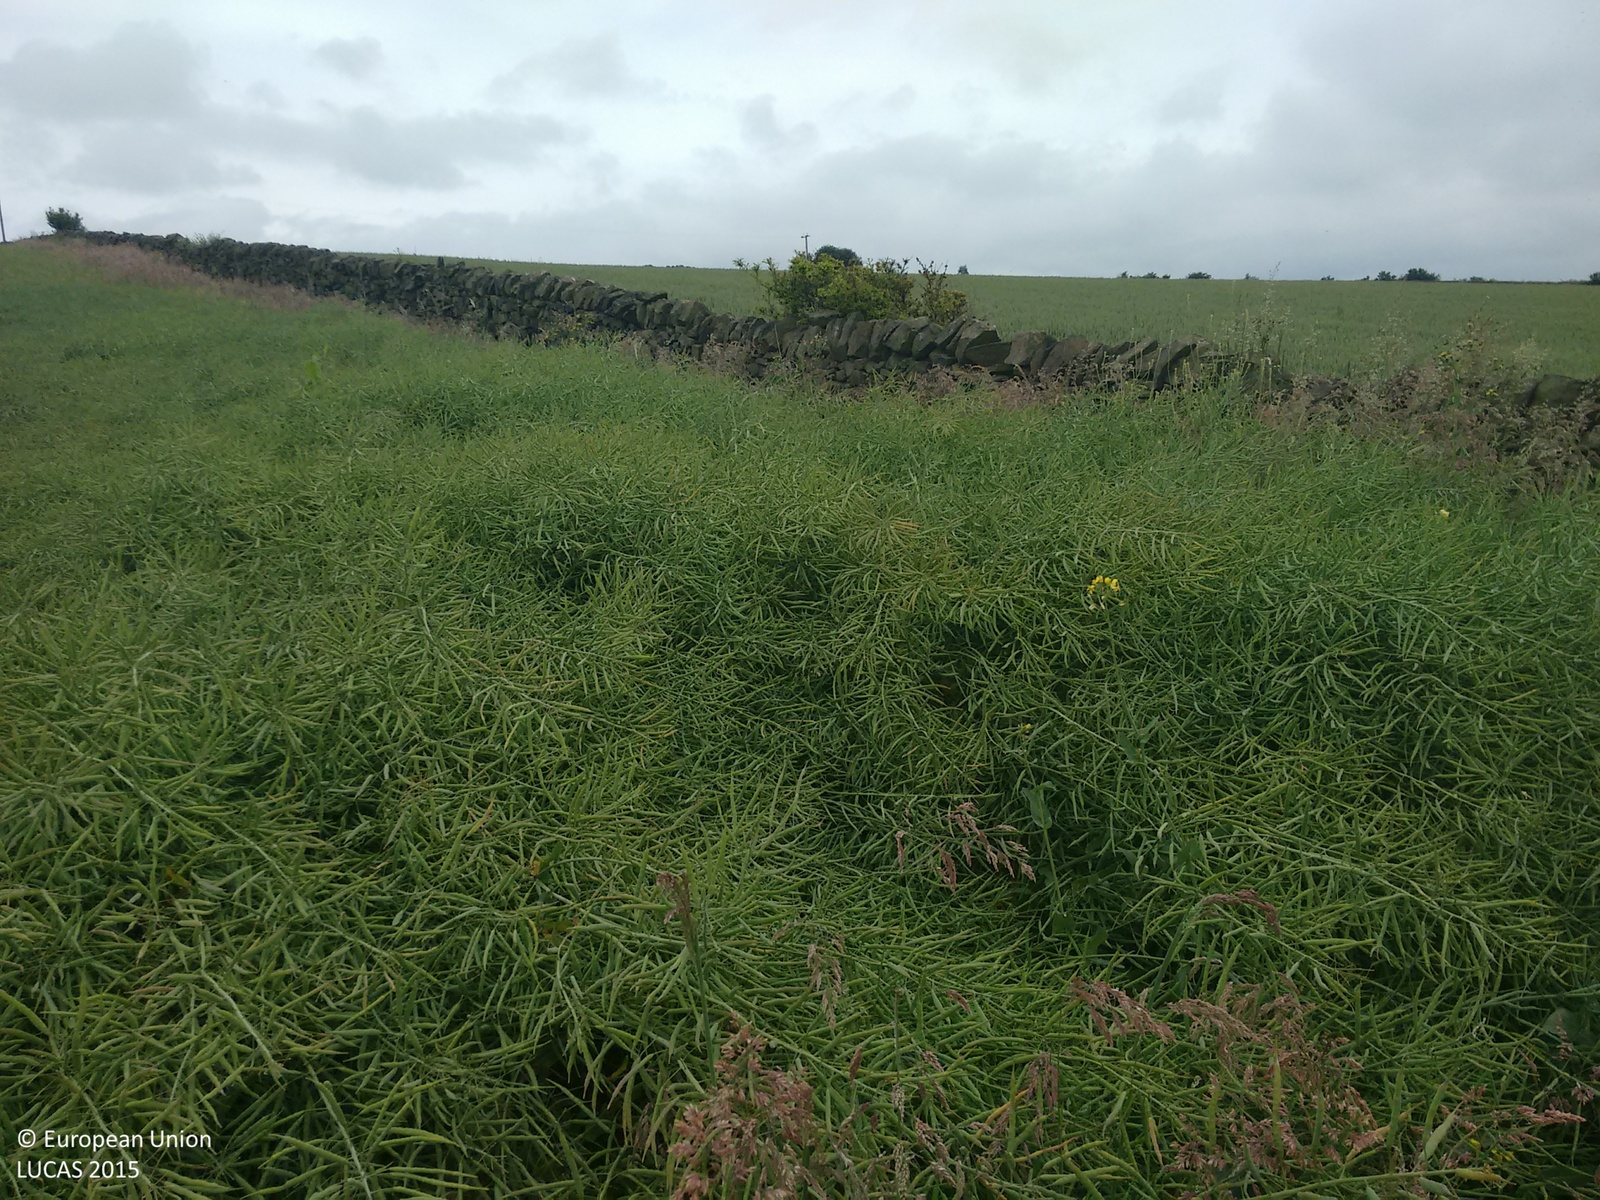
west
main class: Cropland
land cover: Rape and turnip rape
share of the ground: > 75 %
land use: Agriculture (excluding fallow land and kitchen gardens)
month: June
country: GB
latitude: 53.2707
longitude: -1.4911
